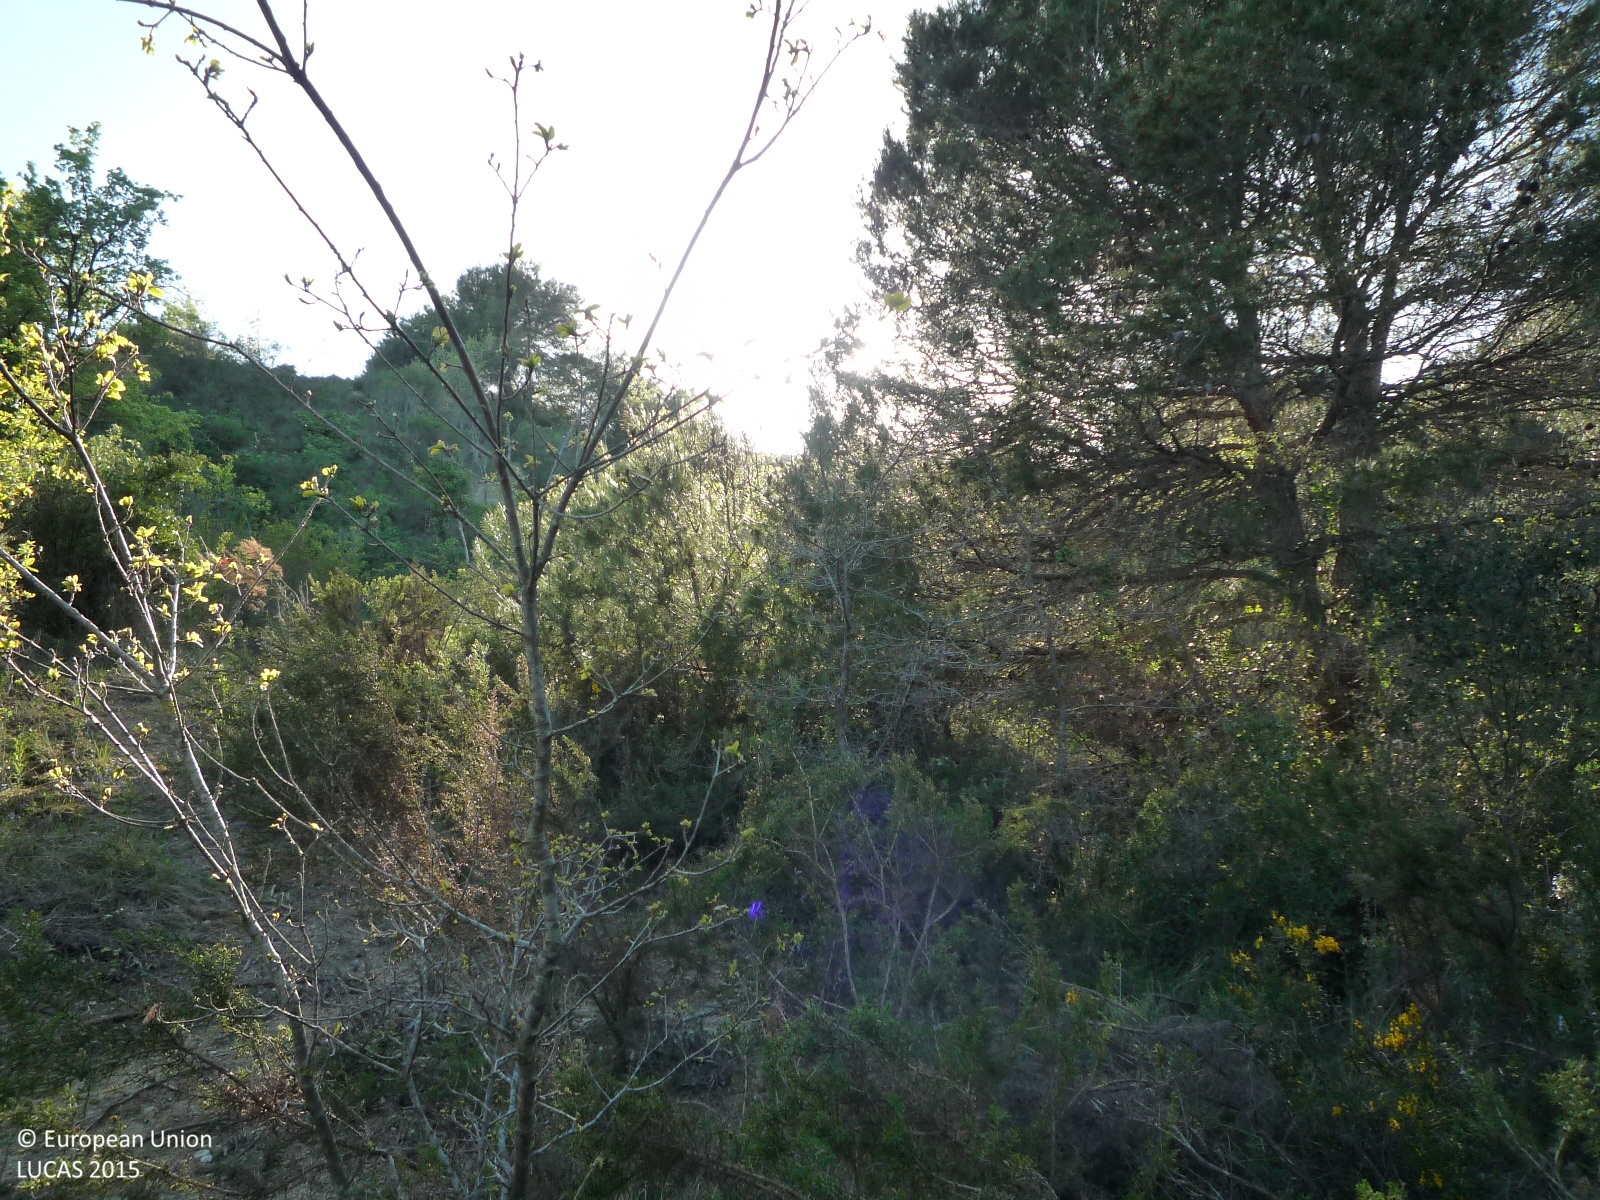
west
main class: Woodland
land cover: Pine dominated mixed woodland
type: coniferous forest of the mediterranean region
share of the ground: > 75 %
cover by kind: coniferous forest trees 55 %, broadleaved forest trees 30 %, shrubs 15 %
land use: Semi-natural and natural areas not in use
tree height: > 5 m
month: April
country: ES
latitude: 41.4195
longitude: 1.6535
